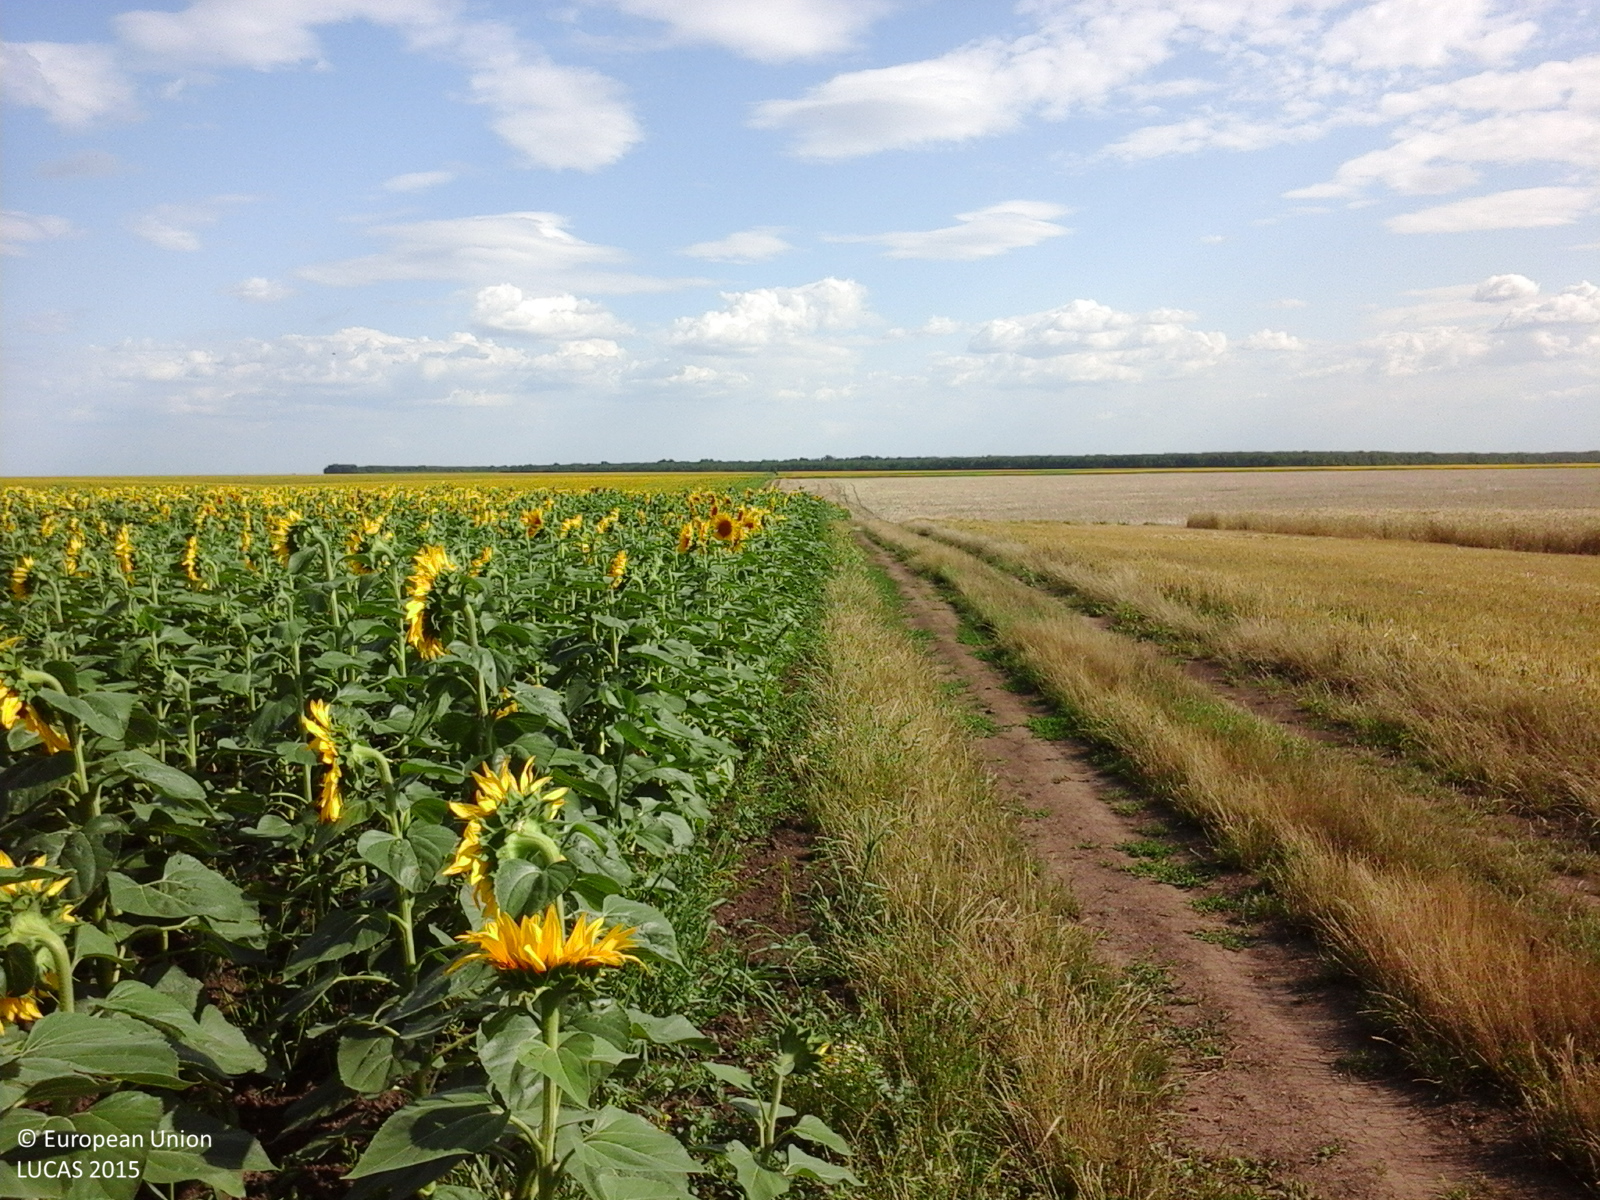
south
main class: Cropland
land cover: Sunflower
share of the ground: > 75 %
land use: Agriculture (excluding fallow land and kitchen gardens)
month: July
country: RO
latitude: 44.0777
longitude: 24.8717
